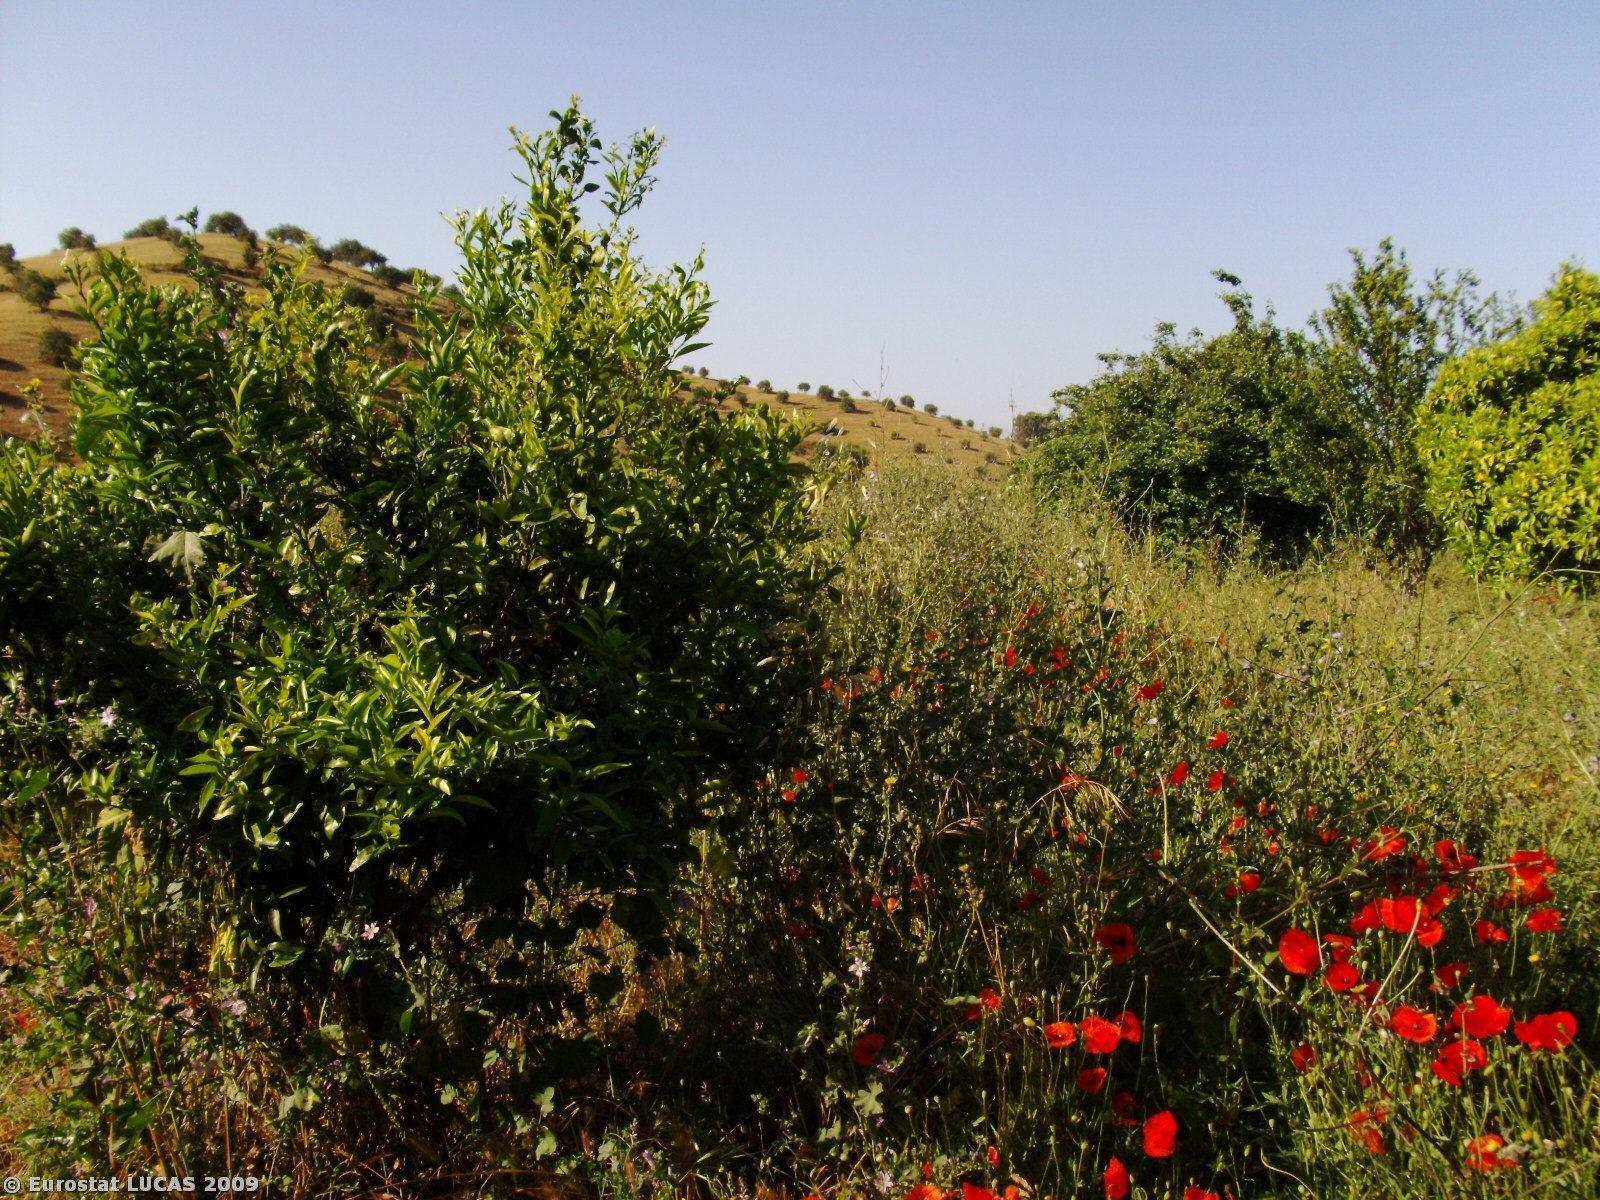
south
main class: Cropland
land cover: Oranges
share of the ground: 50 - 75 %
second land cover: Spontaneously vegetated surfaces
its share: 10 - 25 %
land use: Agriculture (excluding fallow land and kitchen gardens)
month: May
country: PT
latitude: 37.2634
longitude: -7.4703
